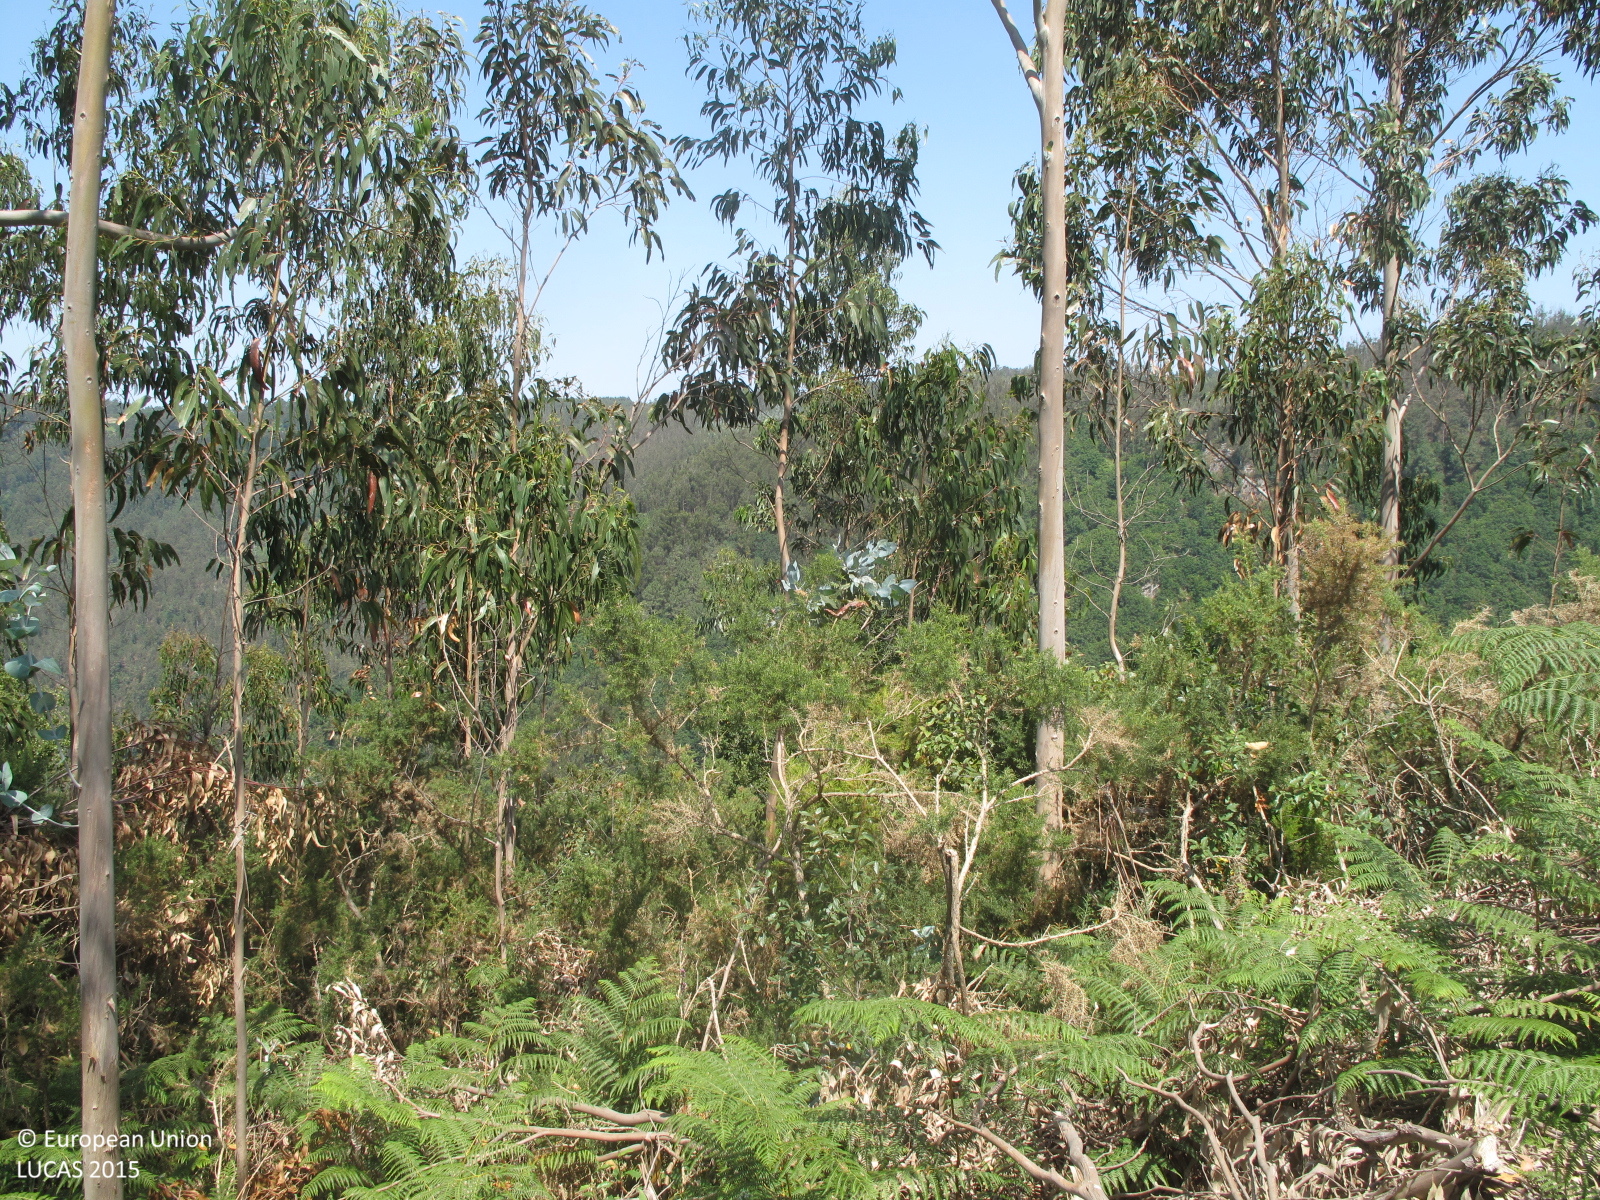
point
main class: Woodland
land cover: Broadleaved woodland
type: exotic forest
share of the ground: 25 - 50 %
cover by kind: shrubs 60 %, broadleaved forest trees 30 %, herbaceous plants 10 %
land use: Forestry
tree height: > 5 m
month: July
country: ES
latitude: 43.4216
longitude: -8.1196
